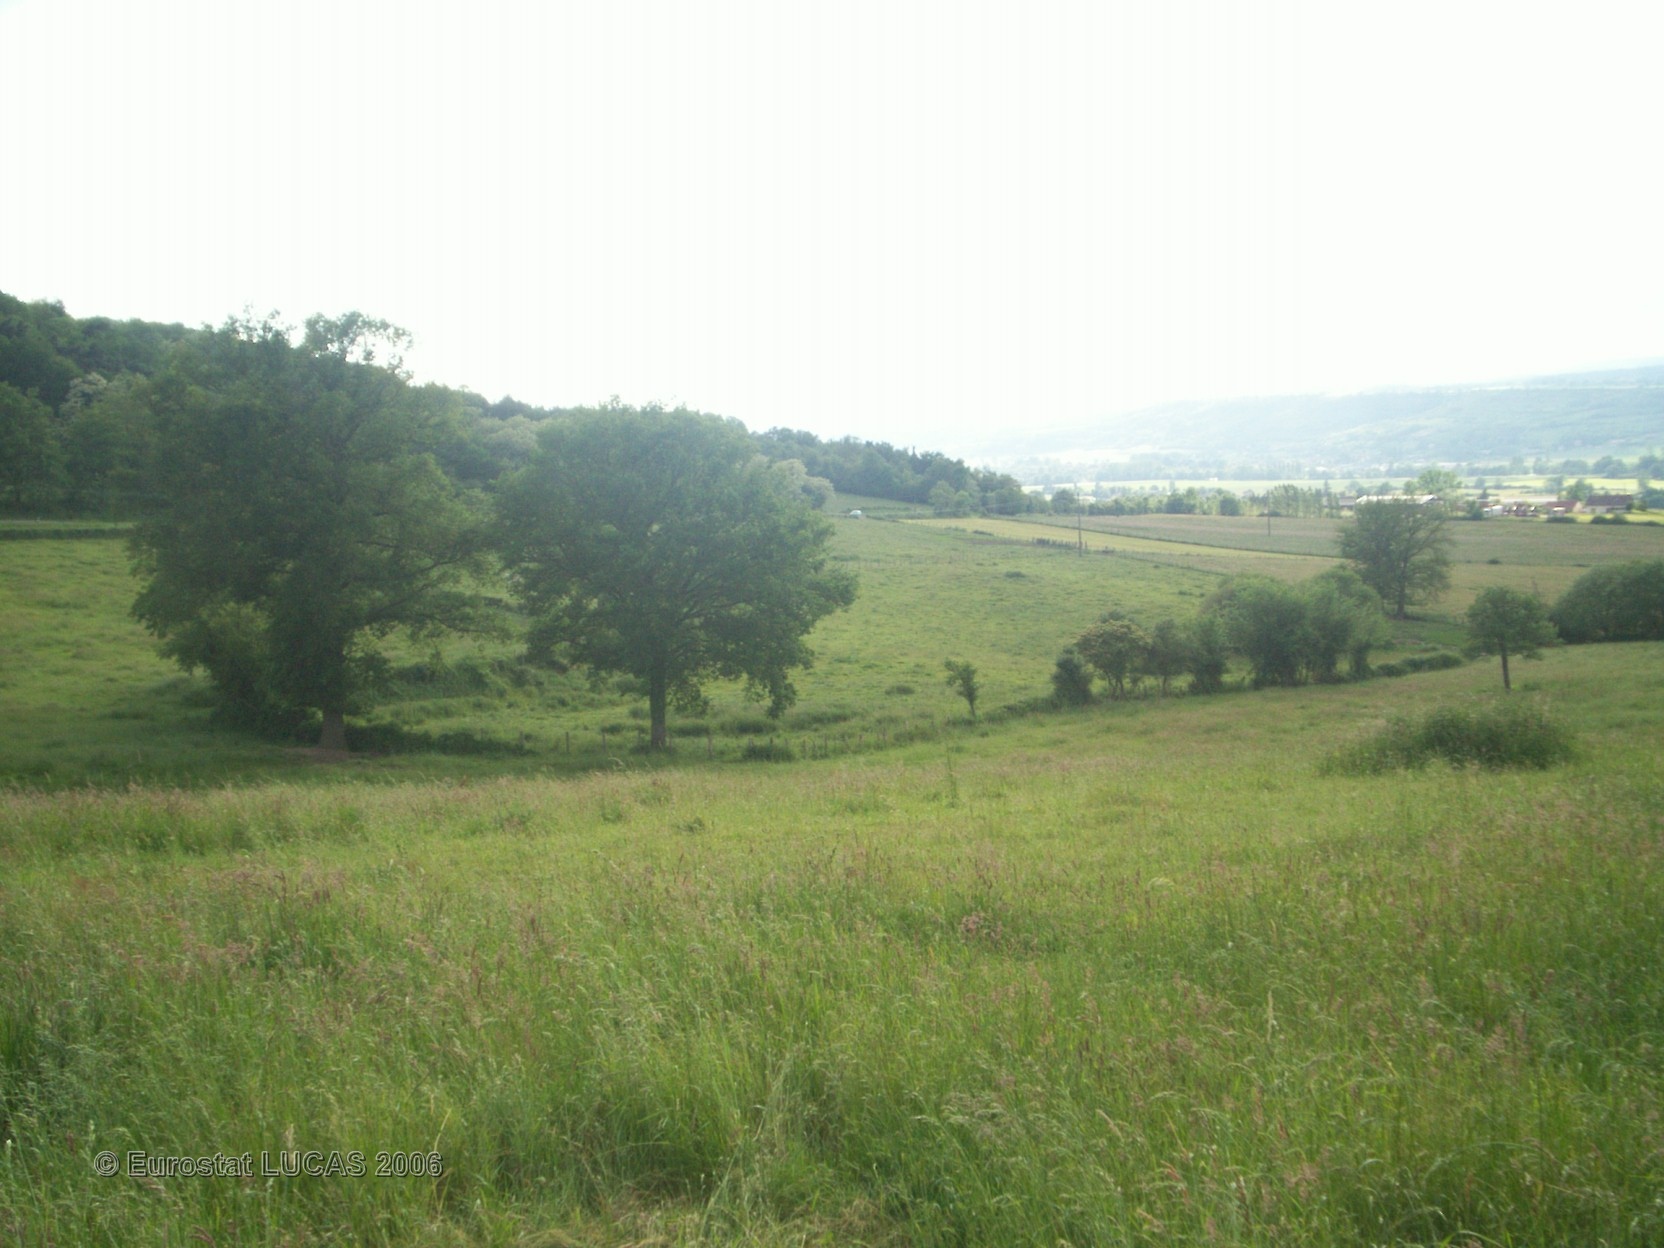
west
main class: Grassland
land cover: Grassland without tree/shrub cover
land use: Agriculture (excluding fallow land and kitchen gardens)
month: June
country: FR
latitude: 46.1121
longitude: 3.1284
